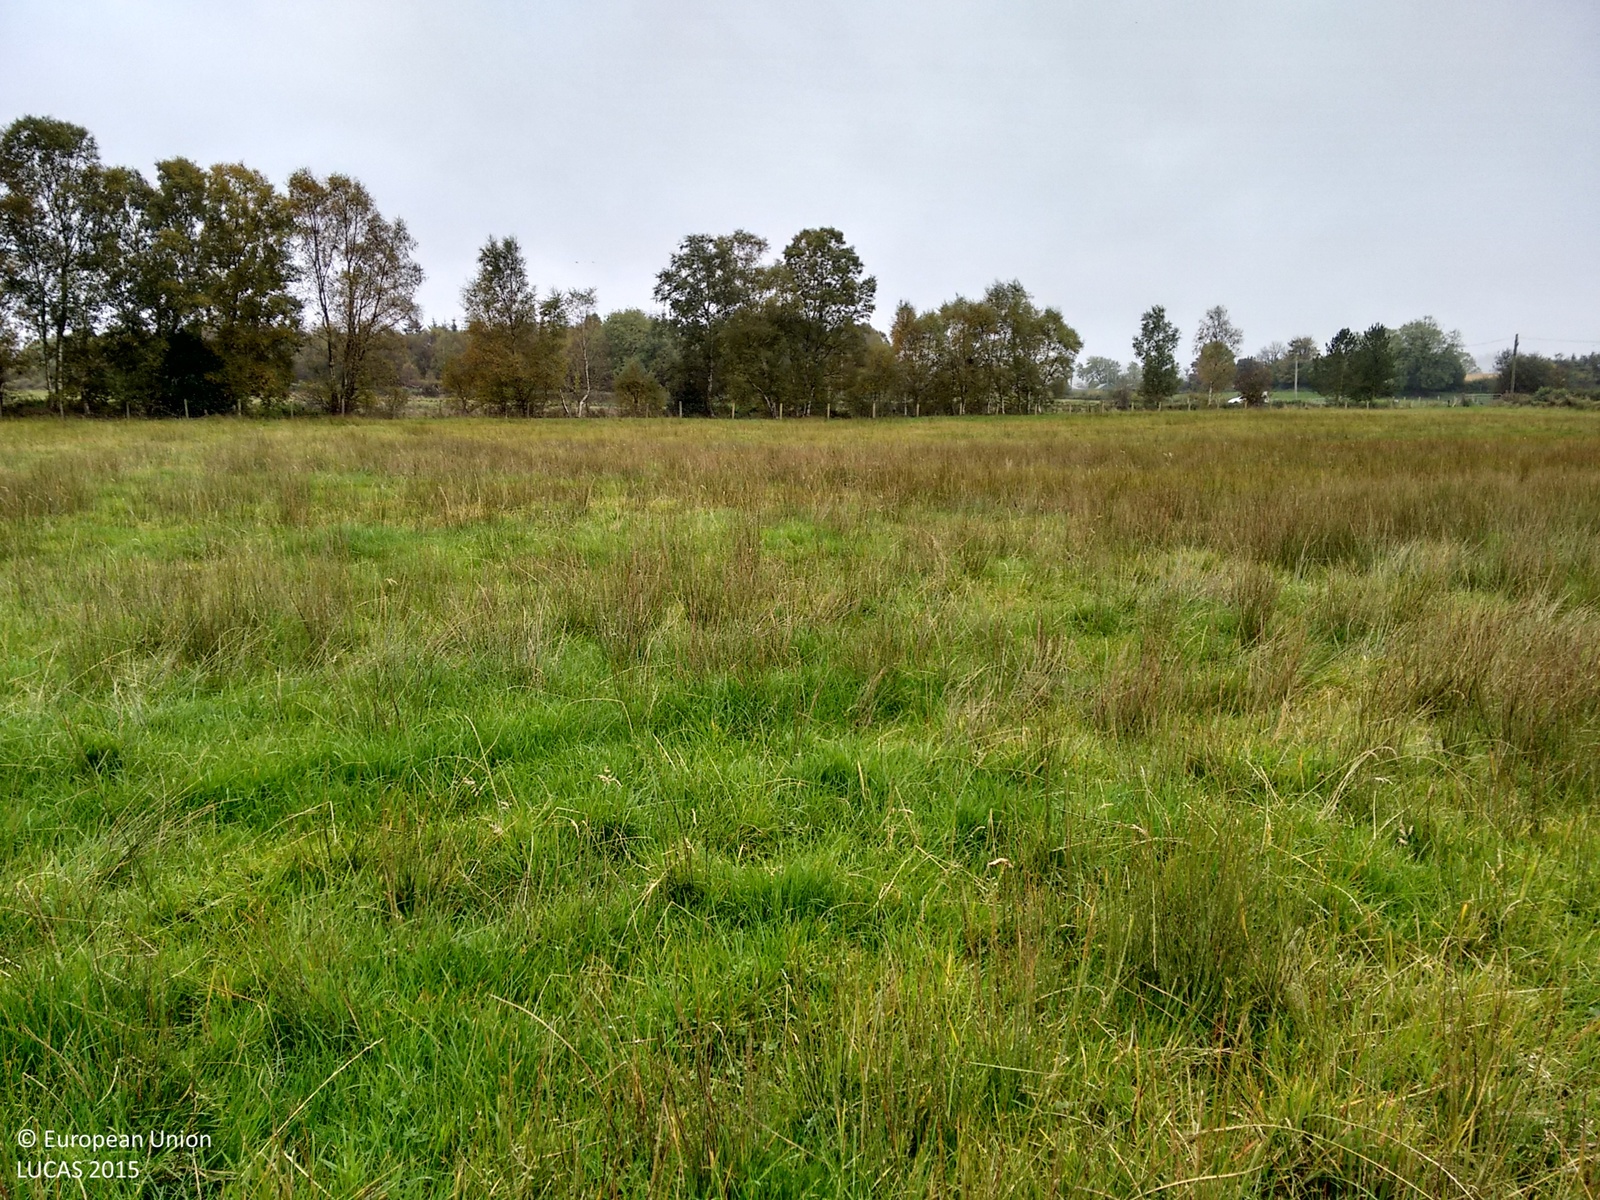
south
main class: Grassland
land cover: Grassland without tree/shrub cover
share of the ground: > 75 %
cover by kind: herbaceous plants 100 %
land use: Agriculture (excluding fallow land and kitchen gardens)
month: October
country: GB
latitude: 54.6479
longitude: -7.4327
